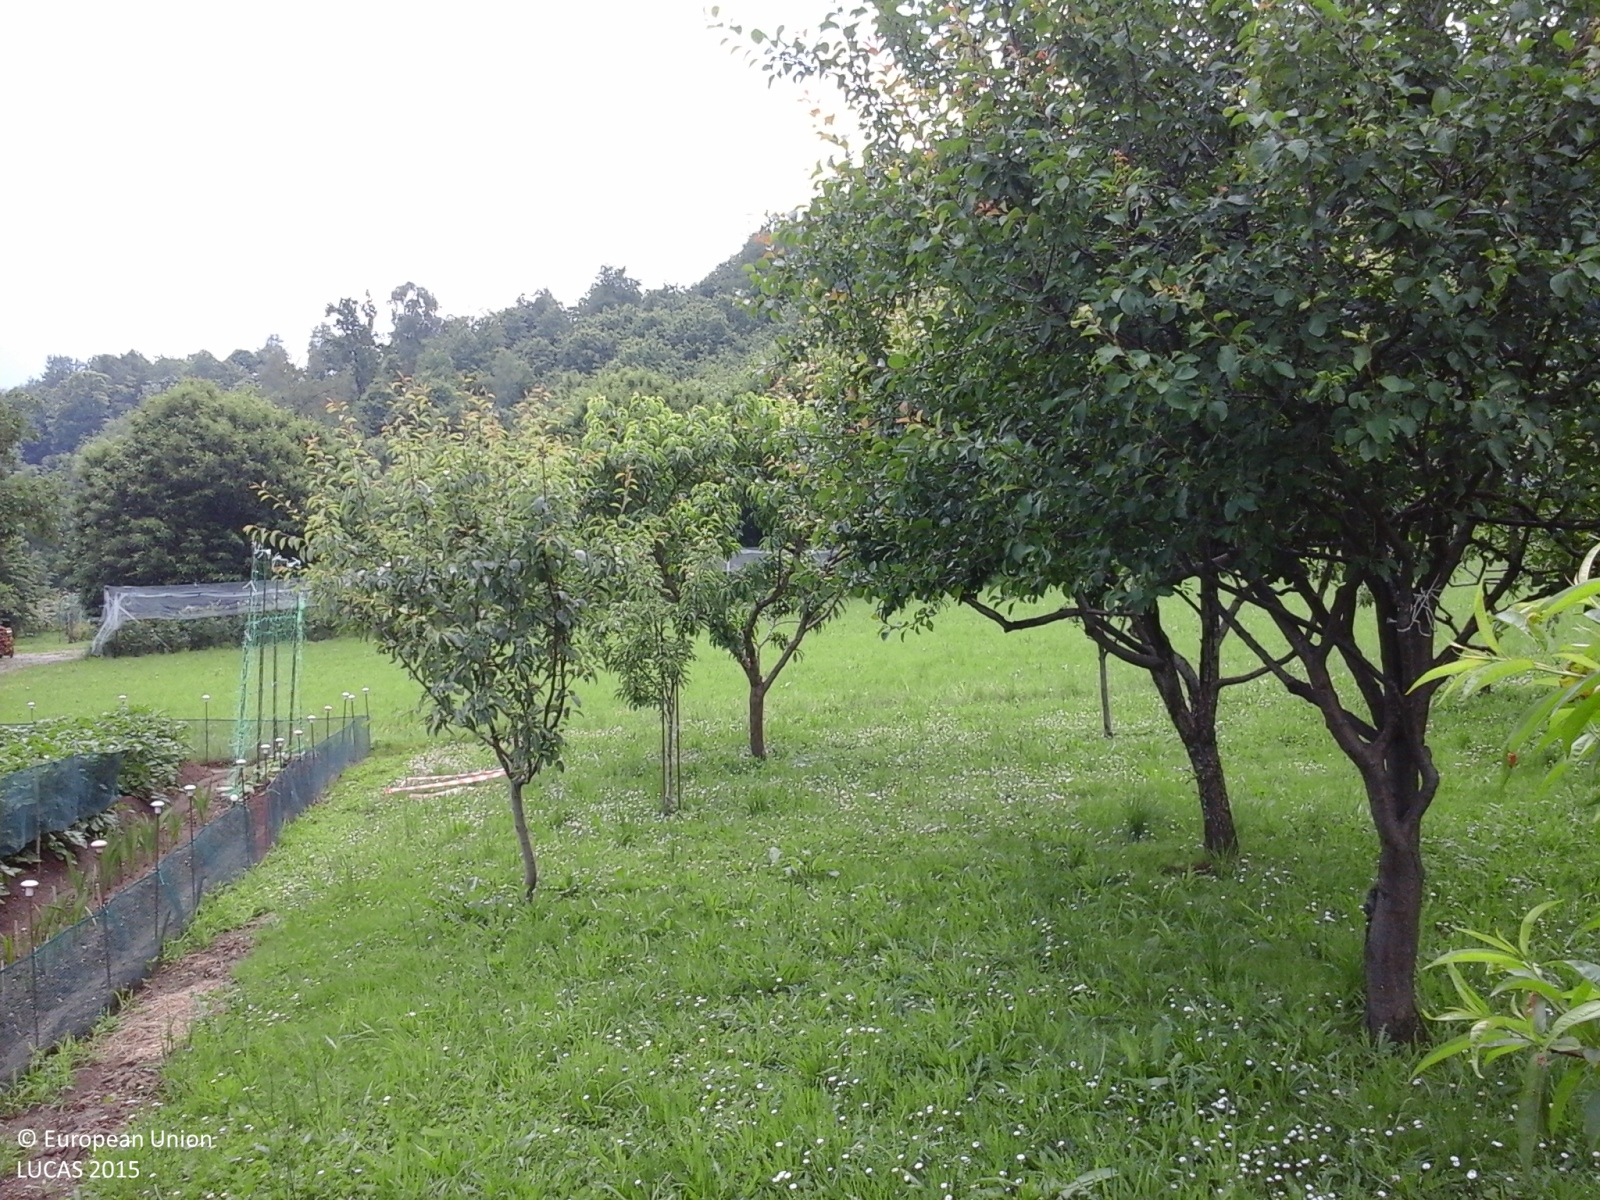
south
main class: Grassland
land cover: Grassland with sparse tree/shrub cover
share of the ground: > 75 %
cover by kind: herbaceous plants 95 %, broadleaved forest trees 5 %
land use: Agriculture (excluding fallow land and kitchen gardens)
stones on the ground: < 10 %
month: May
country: IT
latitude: 44.7302
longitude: 7.2903
